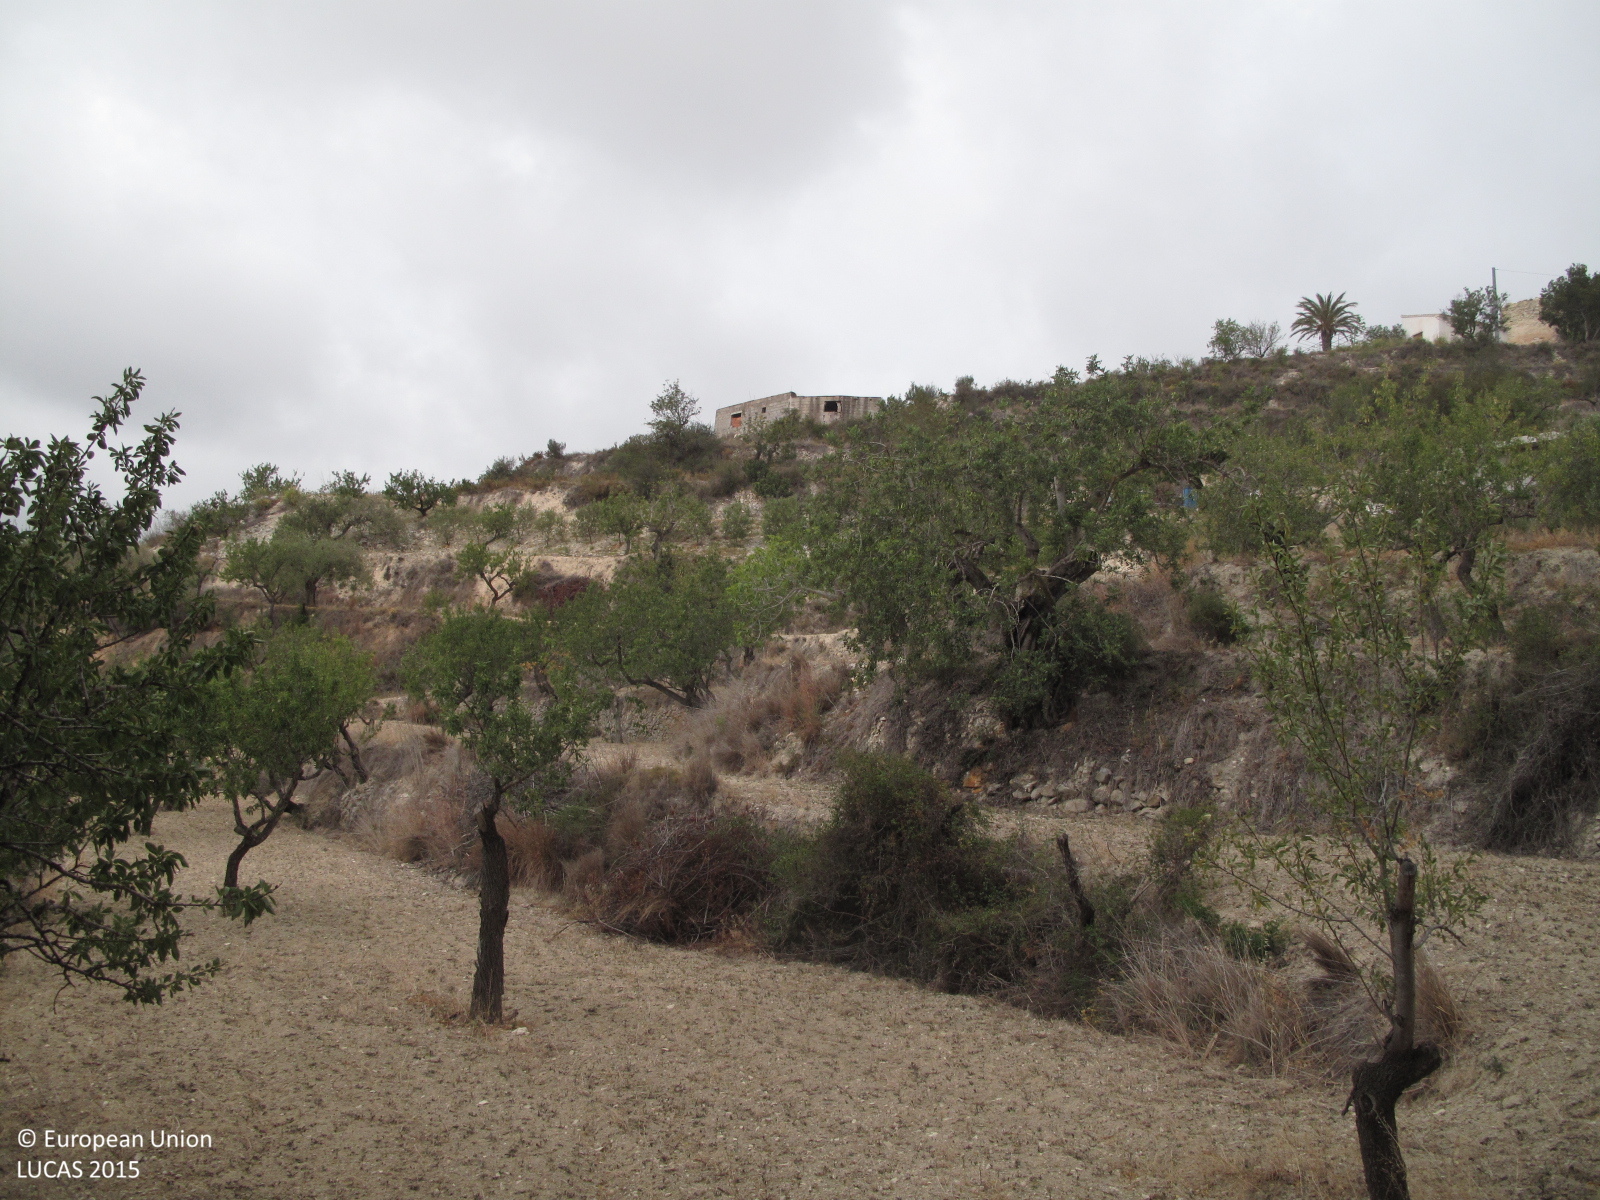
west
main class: Woodland
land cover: Pine dominated coniferous woodland
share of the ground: > 75 %
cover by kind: coniferous forest trees 90 %, shrubs 10 %
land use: Semi-natural and natural areas not in use
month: May
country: ES
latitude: 38.7022
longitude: 0.0431
